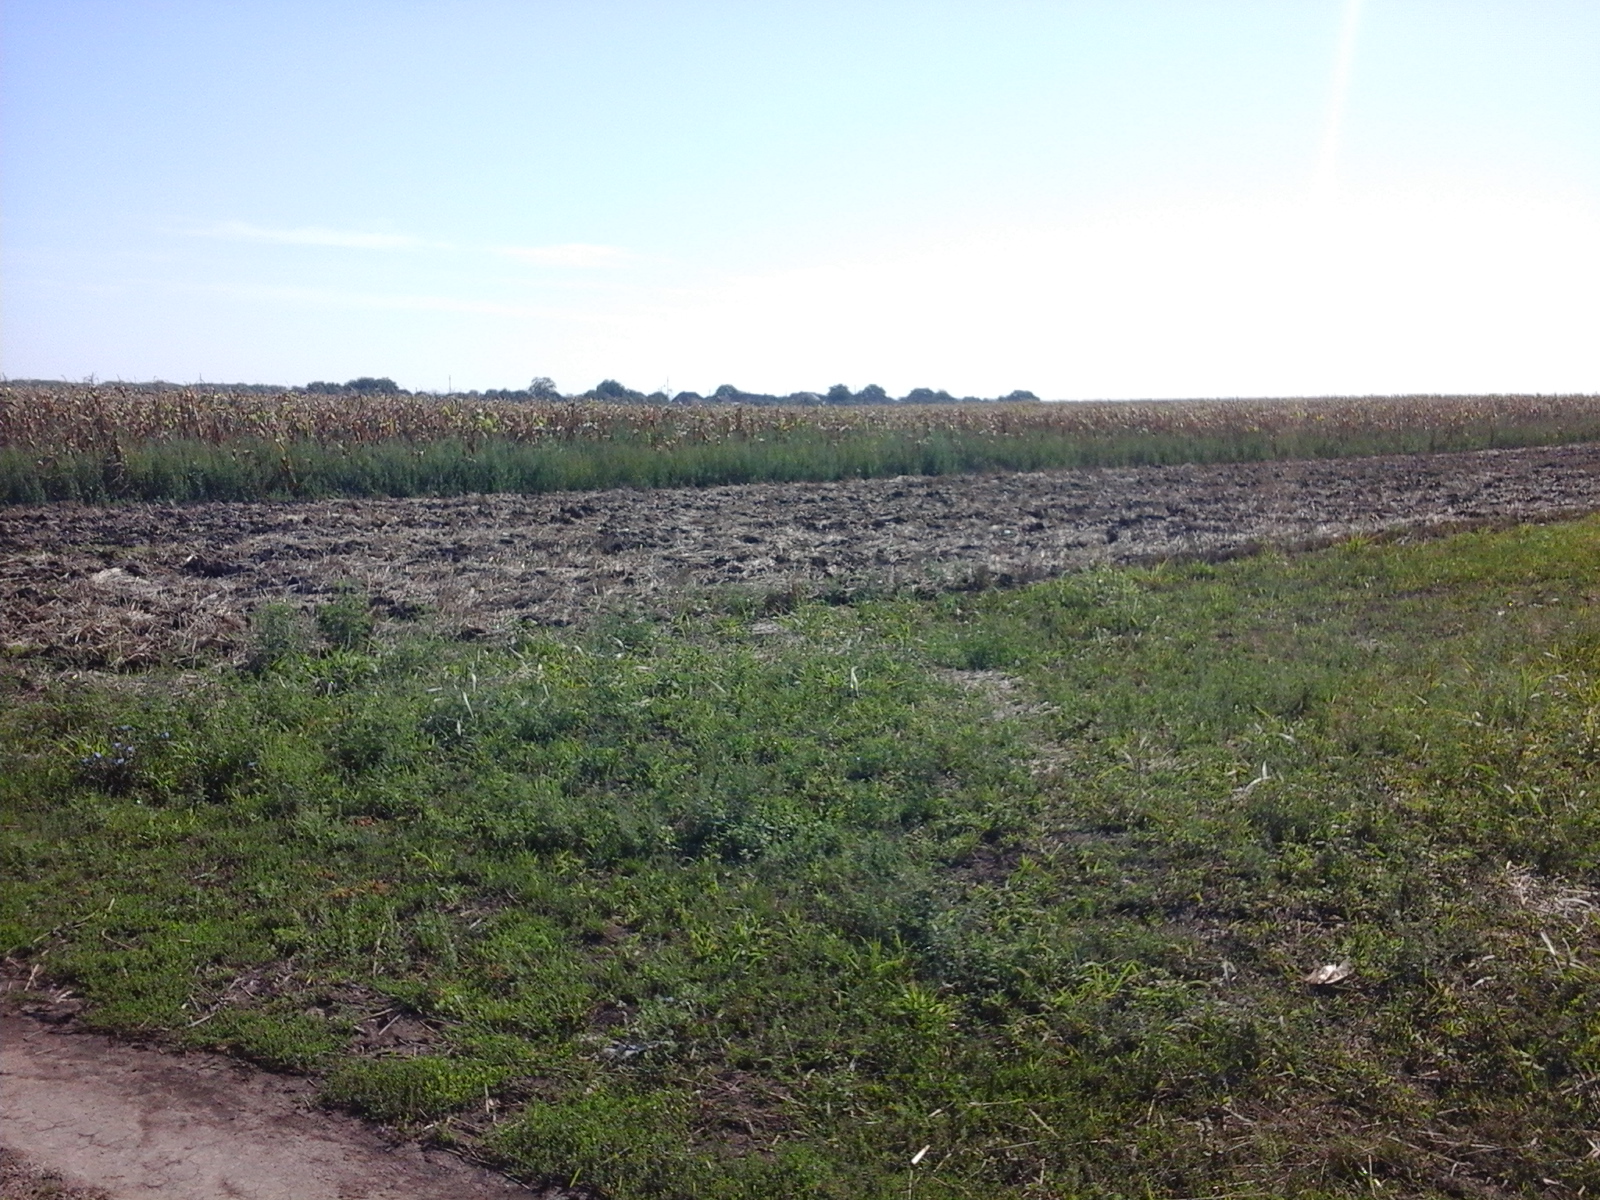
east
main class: Cropland
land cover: Sunflower
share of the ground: > 75 %
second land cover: Spontaneously vegetated surfaces
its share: 50 - 75 %
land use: Agriculture (excluding fallow land and kitchen gardens)
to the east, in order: Sunflower; Spontaneously vegetated surfaces; Tracks; Spontaneously vegetated surfaces; Maize
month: August
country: RO
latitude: 45.9013
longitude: 21.0760
